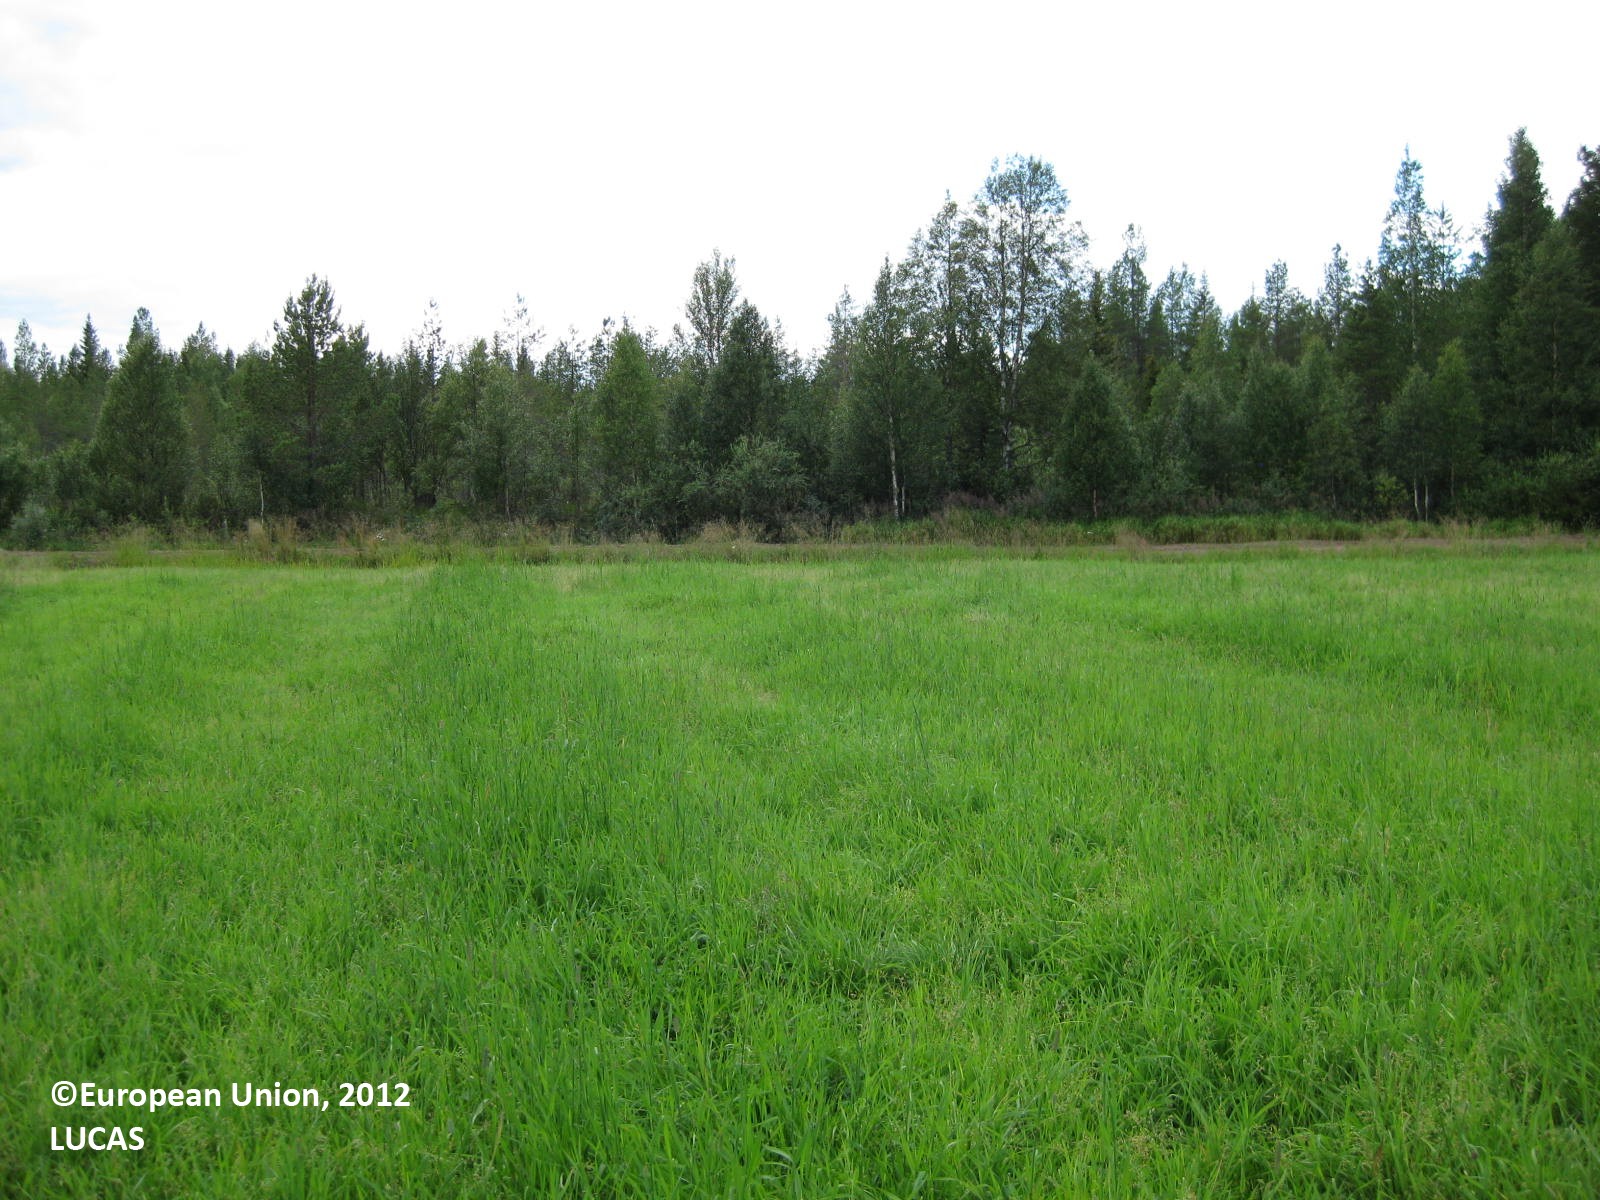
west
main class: Cropland
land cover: Temporary grasslands
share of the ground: > 75 %
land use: Agriculture (excluding fallow land and kitchen gardens)
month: August
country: FI
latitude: 66.4359
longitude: 28.5061
